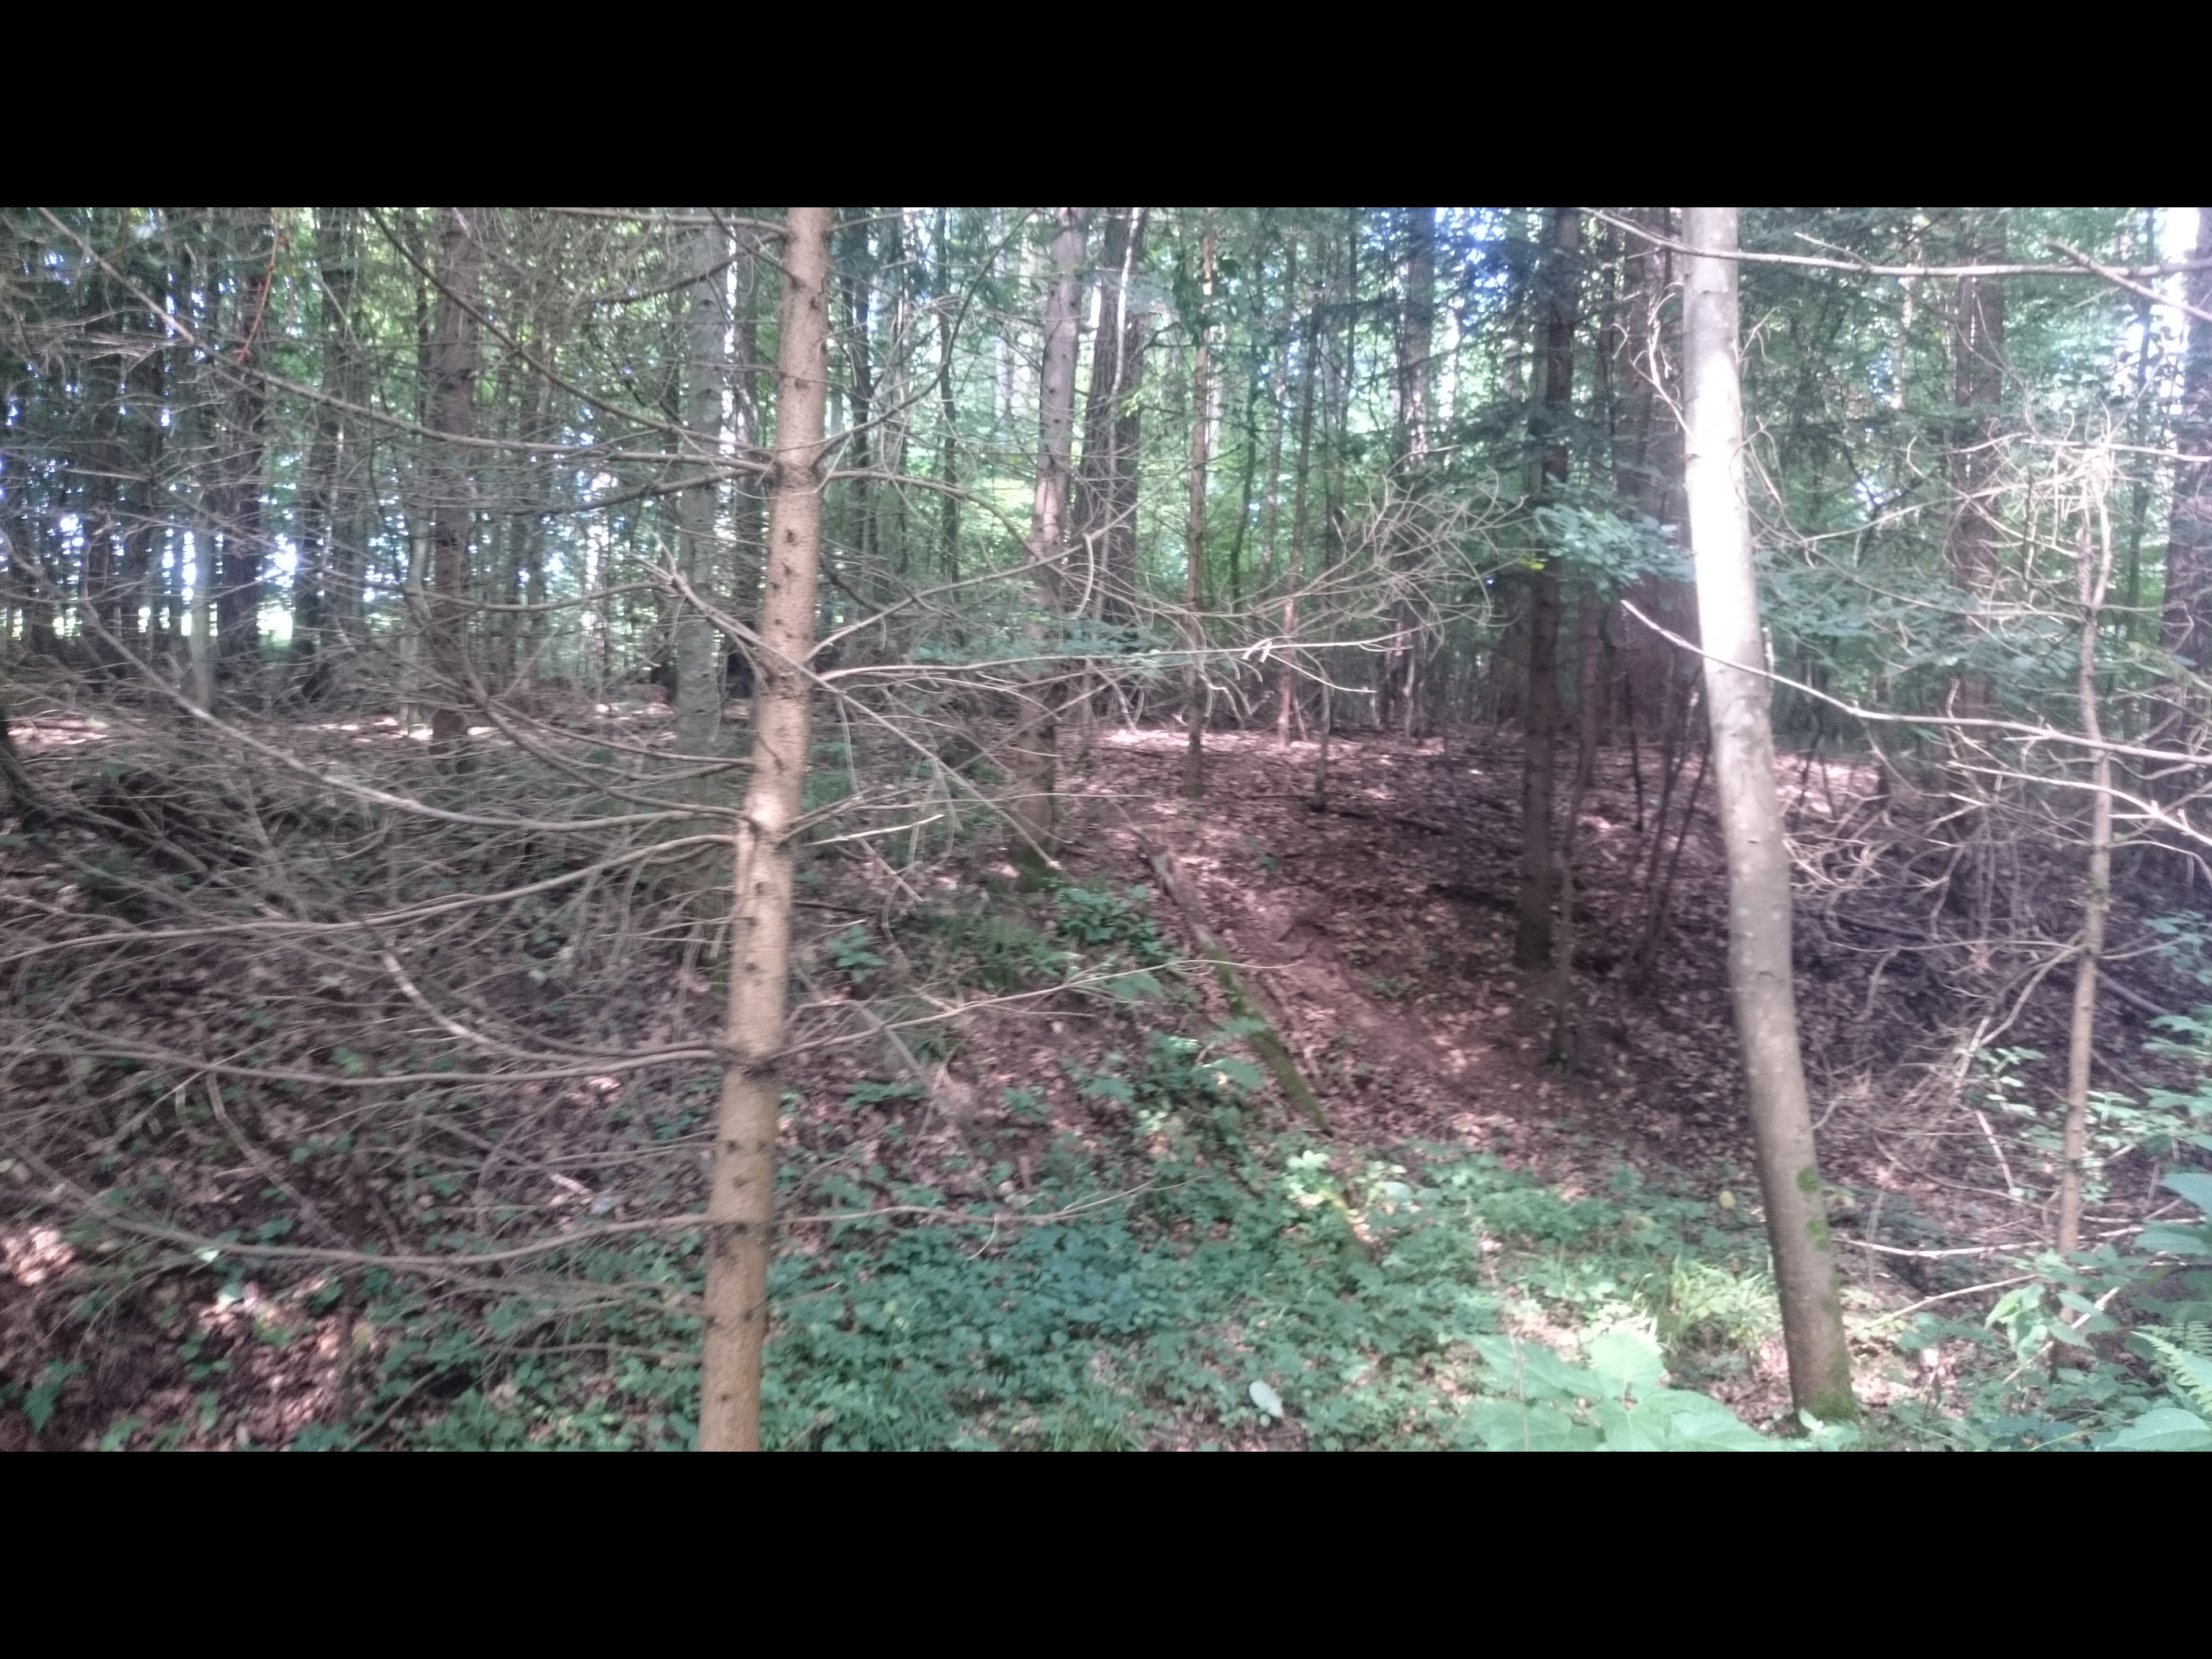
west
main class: Woodland
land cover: Spruce dominated mixed woodland
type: hemiboreal forest and nemoral coniferous forest and mixed broadleaved-coniferous forest
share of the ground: > 75 %
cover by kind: broadleaved forest trees 60 %, coniferous forest trees 30 %, herbaceous plants 10 %
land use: Forestry
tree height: > 5 m
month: July
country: AT
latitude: 47.1429
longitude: 15.6045
